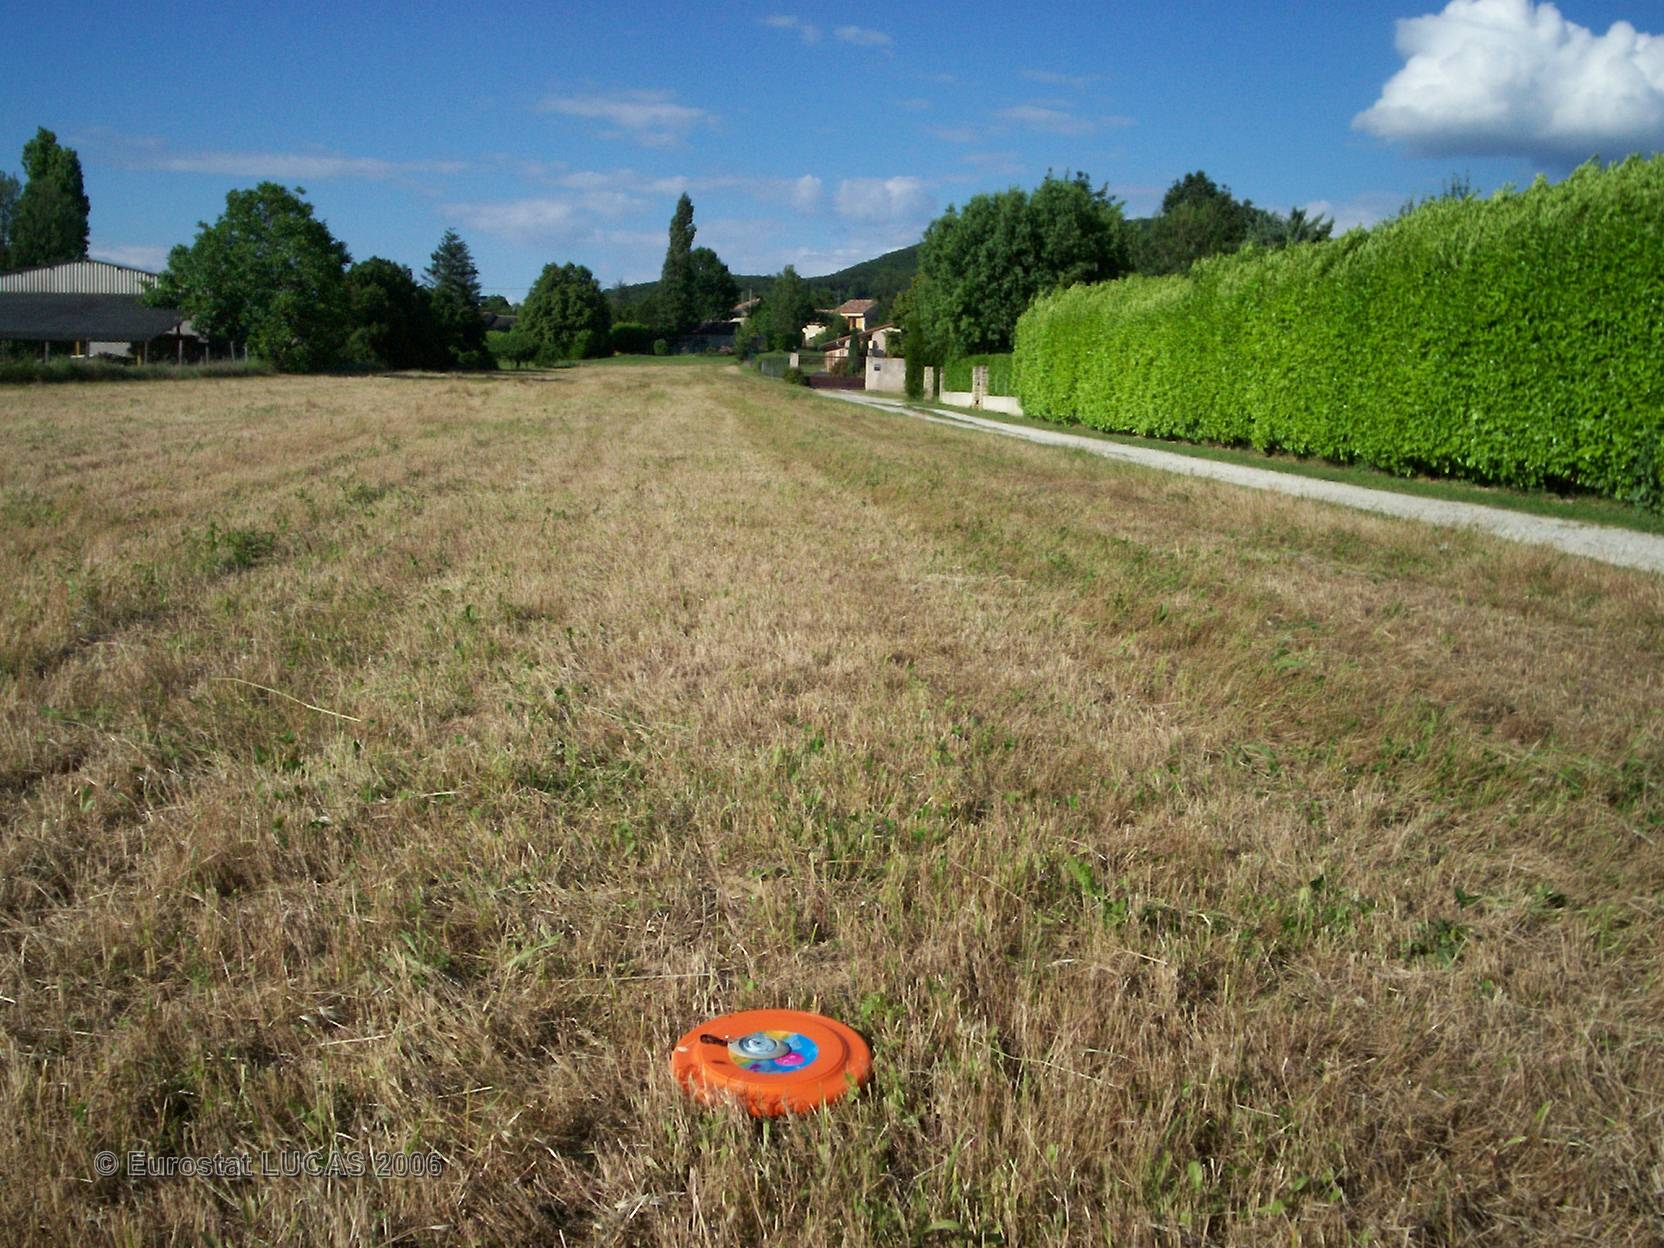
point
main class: Grassland
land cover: Grassland without tree/shrub cover
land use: Agriculture (excluding fallow land and kitchen gardens)
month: May
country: FR
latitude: 44.7269
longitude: 4.8169
